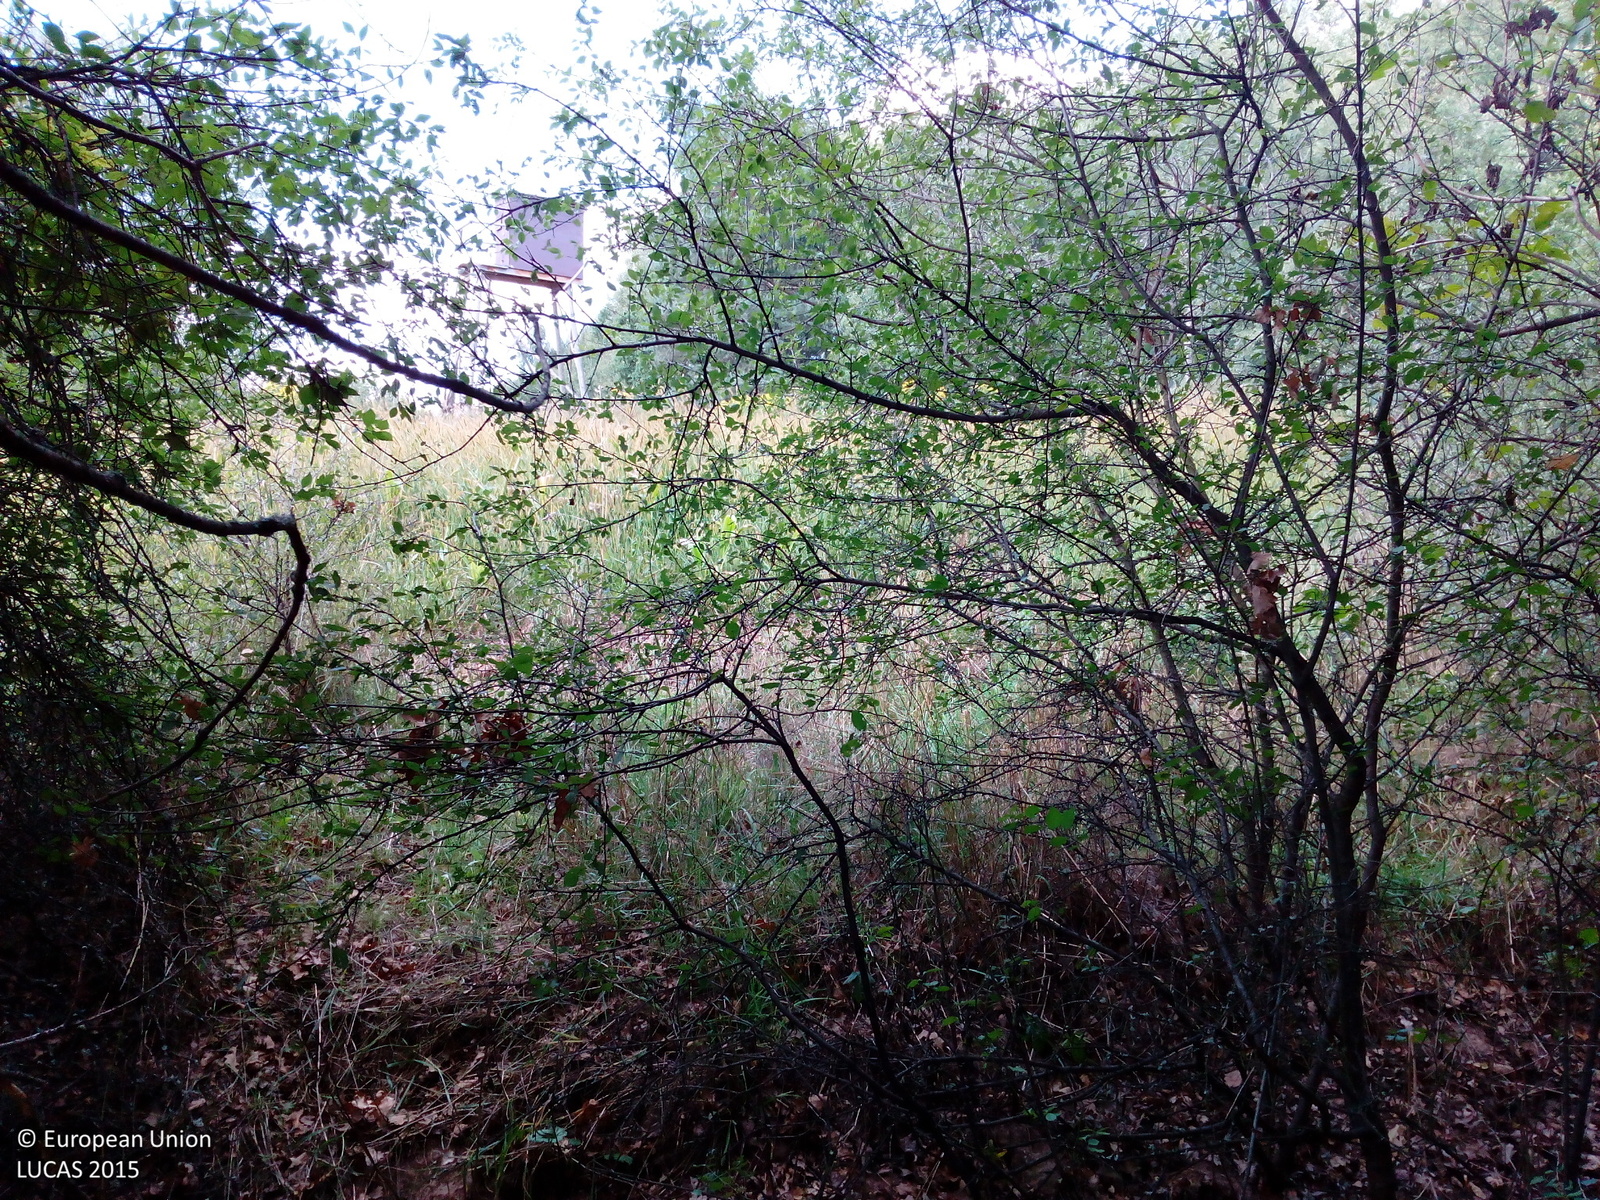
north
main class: Woodland
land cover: Broadleaved woodland
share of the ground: > 75 %
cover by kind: broadleaved forest trees 85 %, shrubs 10 %, unconsolidated bare surface 5 %
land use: Semi-natural and natural areas not in use
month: September
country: DE
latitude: 49.9481
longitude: 9.2616
